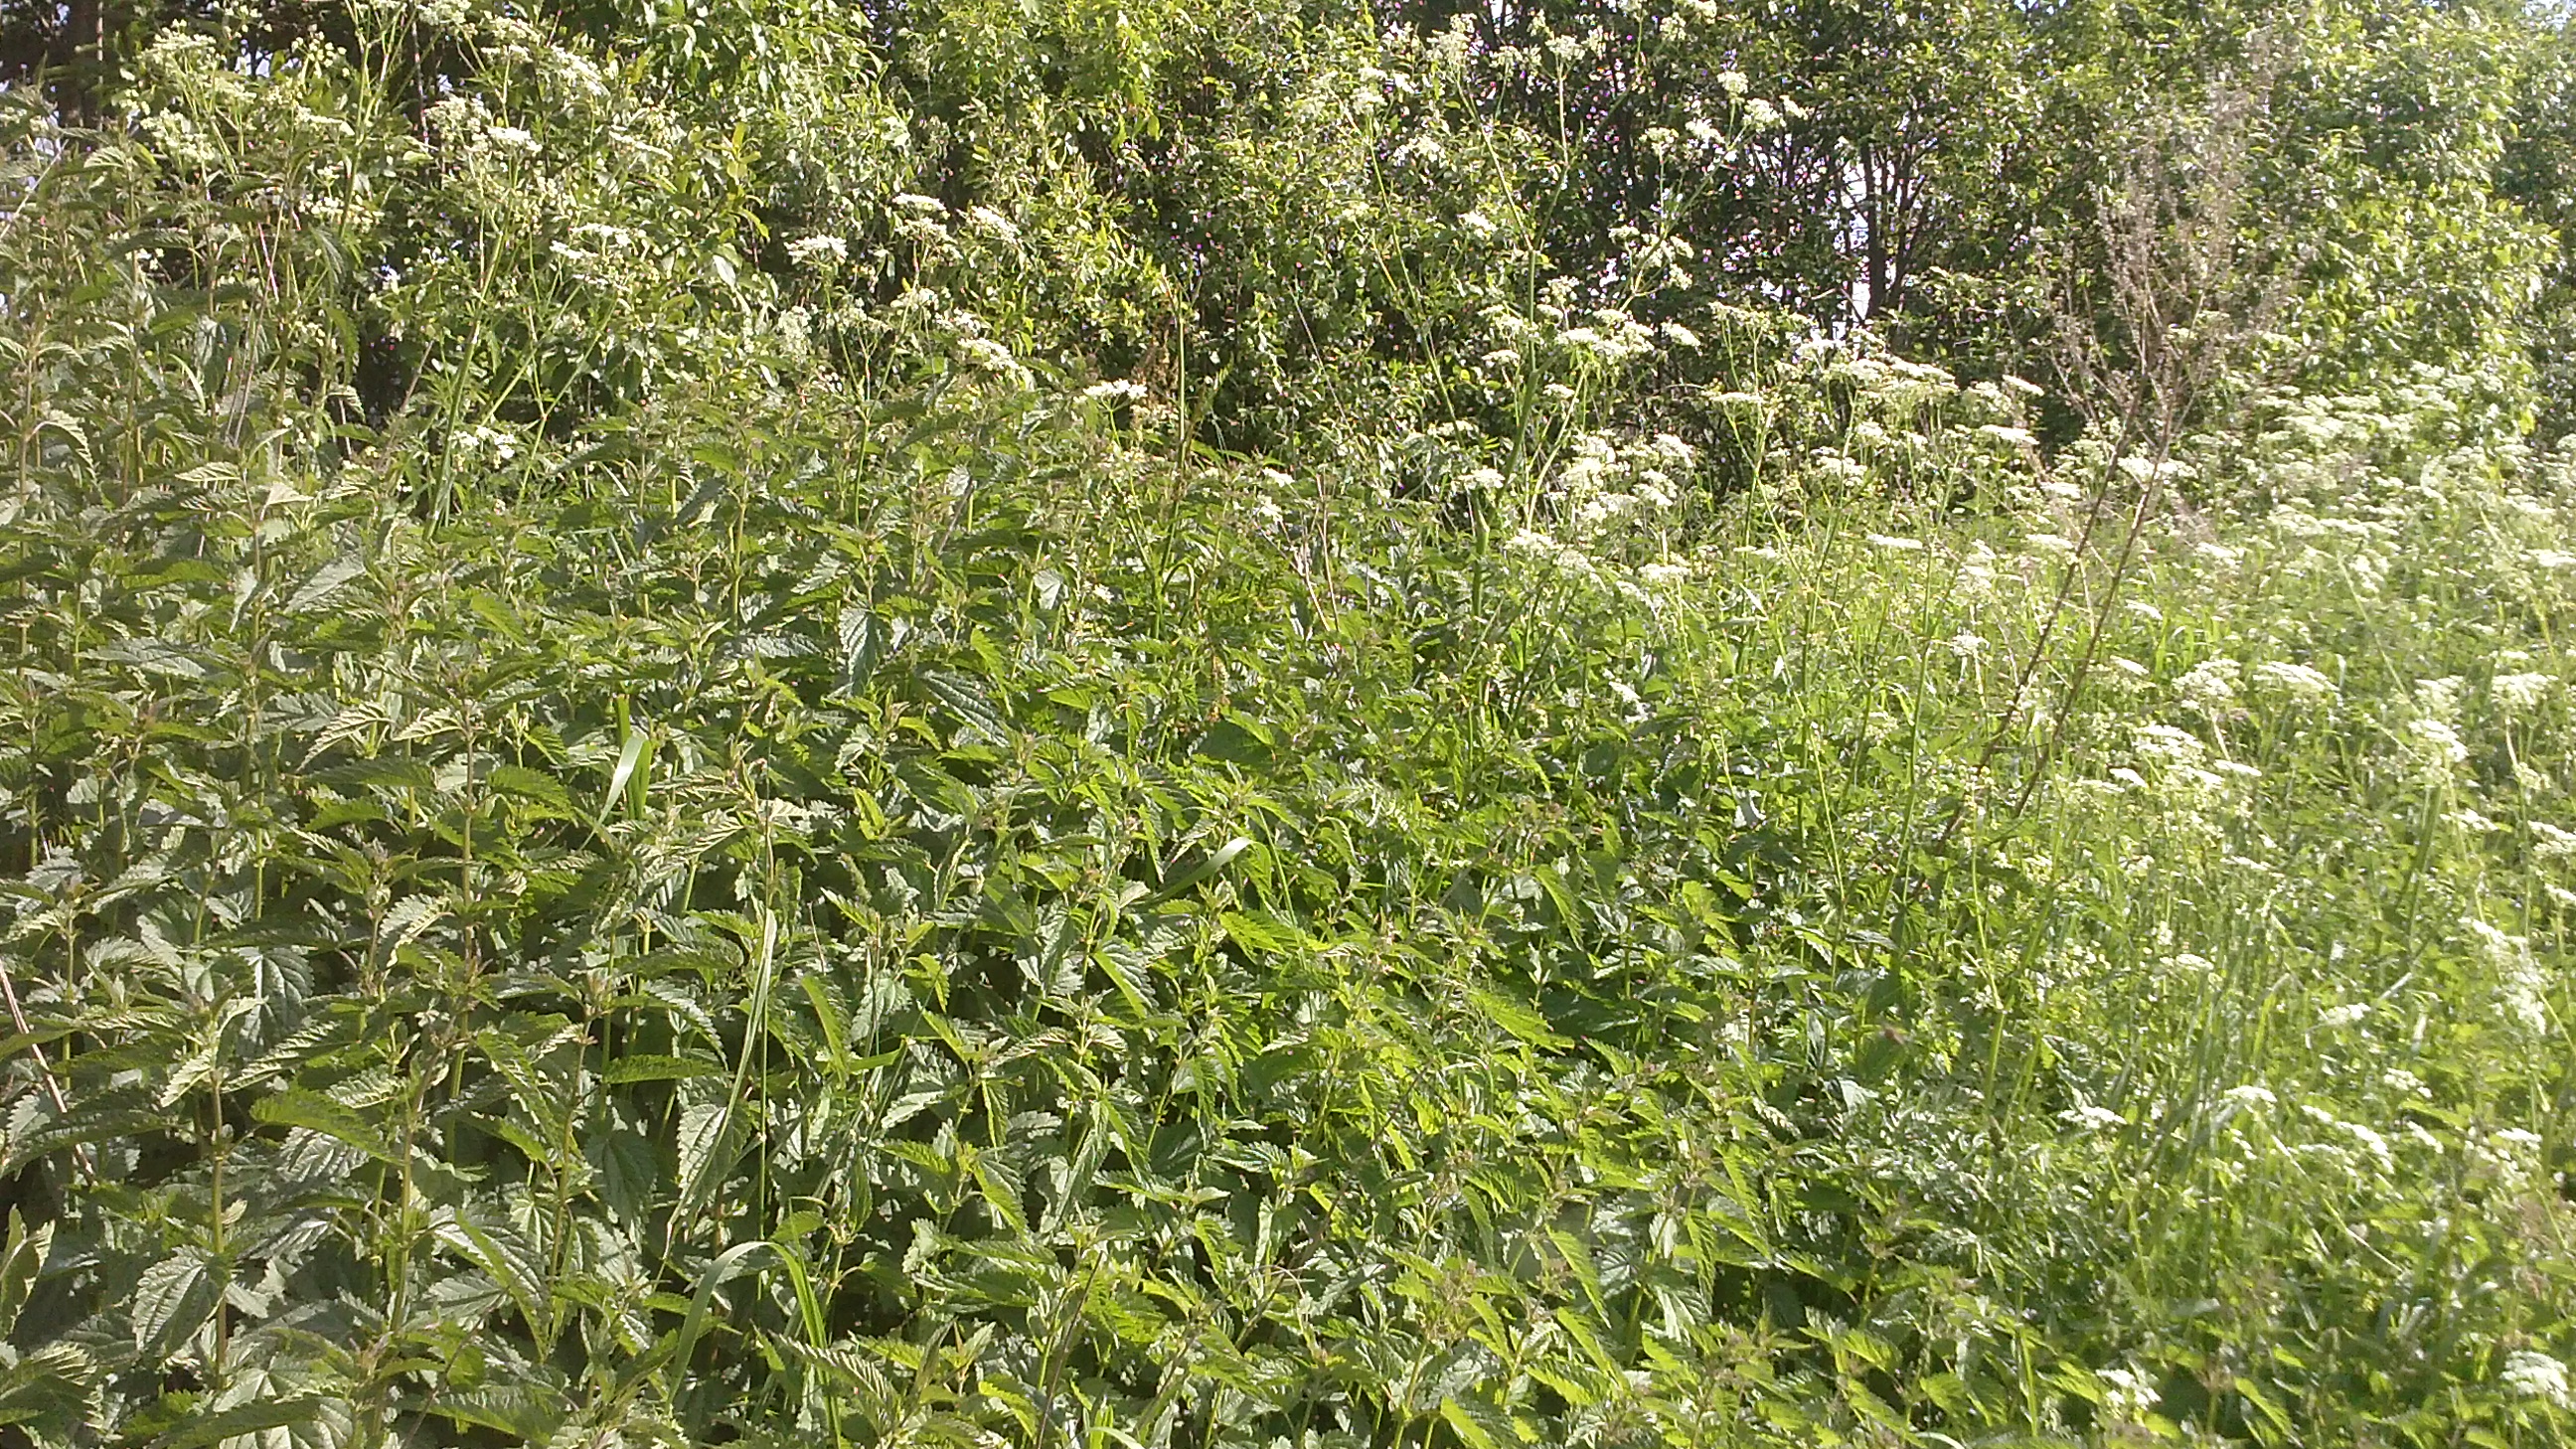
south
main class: Grassland
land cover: Spontaneously vegetated surfaces
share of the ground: > 75 %
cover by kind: herbaceous plants 95 %, shrubs 5 %
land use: Semi-natural and natural areas not in use
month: June
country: LV
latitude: 56.4703
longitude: 27.4660
